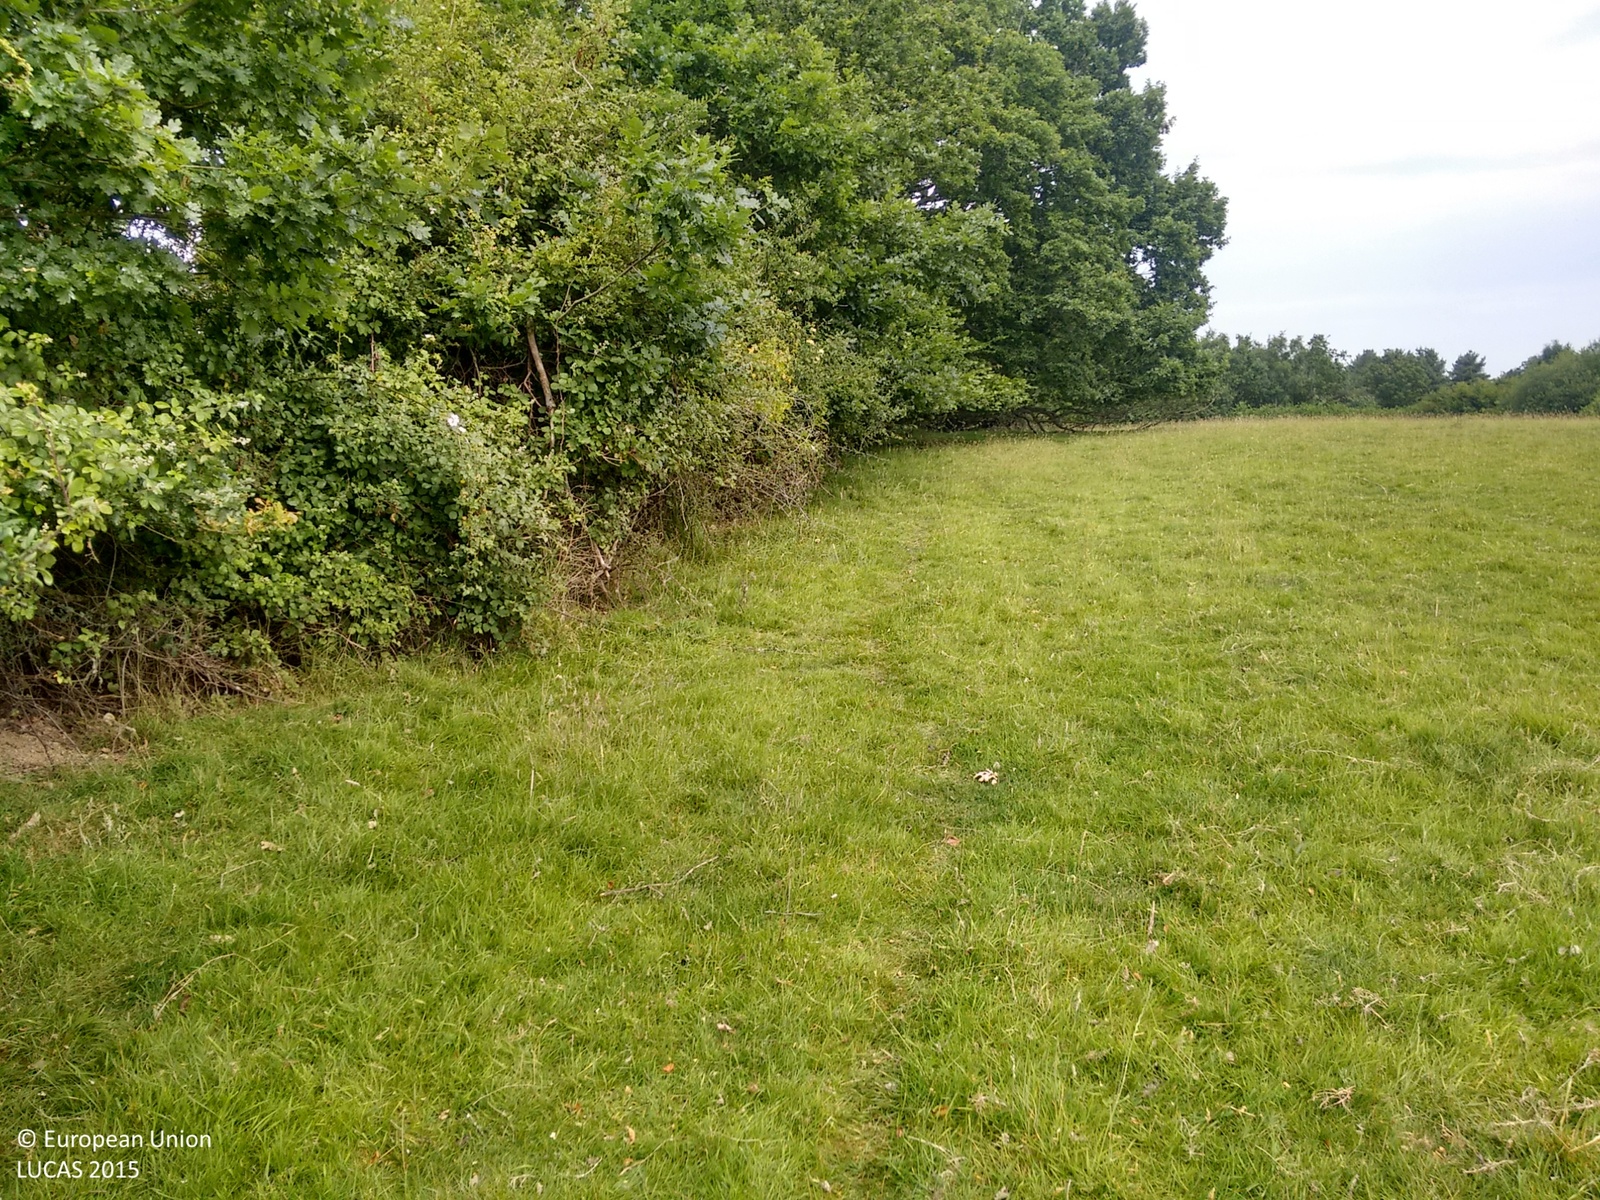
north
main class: Grassland
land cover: Grassland without tree/shrub cover
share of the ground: > 75 %
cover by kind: herbaceous plants 100 %
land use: Agriculture (excluding fallow land and kitchen gardens)
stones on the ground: < 10 %
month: July
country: GB
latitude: 50.9694
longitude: -0.0730
